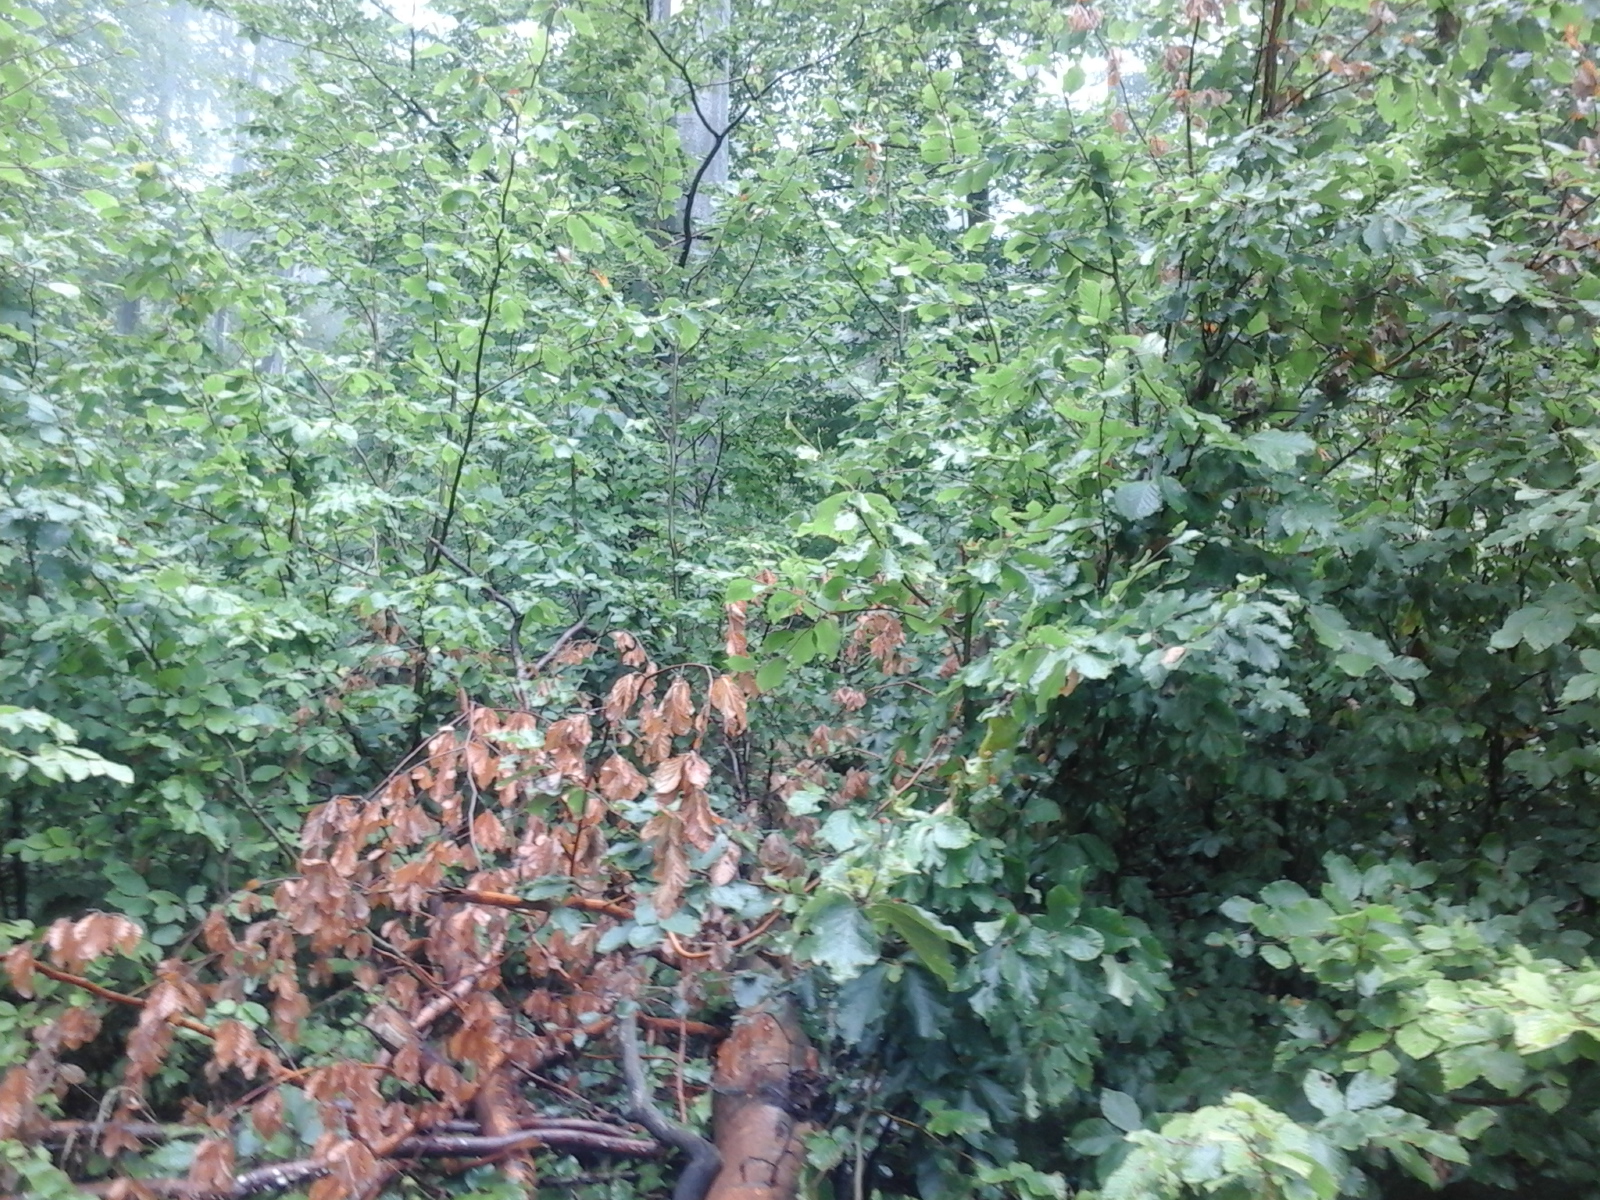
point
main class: Woodland
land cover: Broadleaved woodland
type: beech forest
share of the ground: > 75 %
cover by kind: broadleaved forest trees 100 %
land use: Forestry
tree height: > 5 m
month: August
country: RO
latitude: 45.0404
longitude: 22.7276
